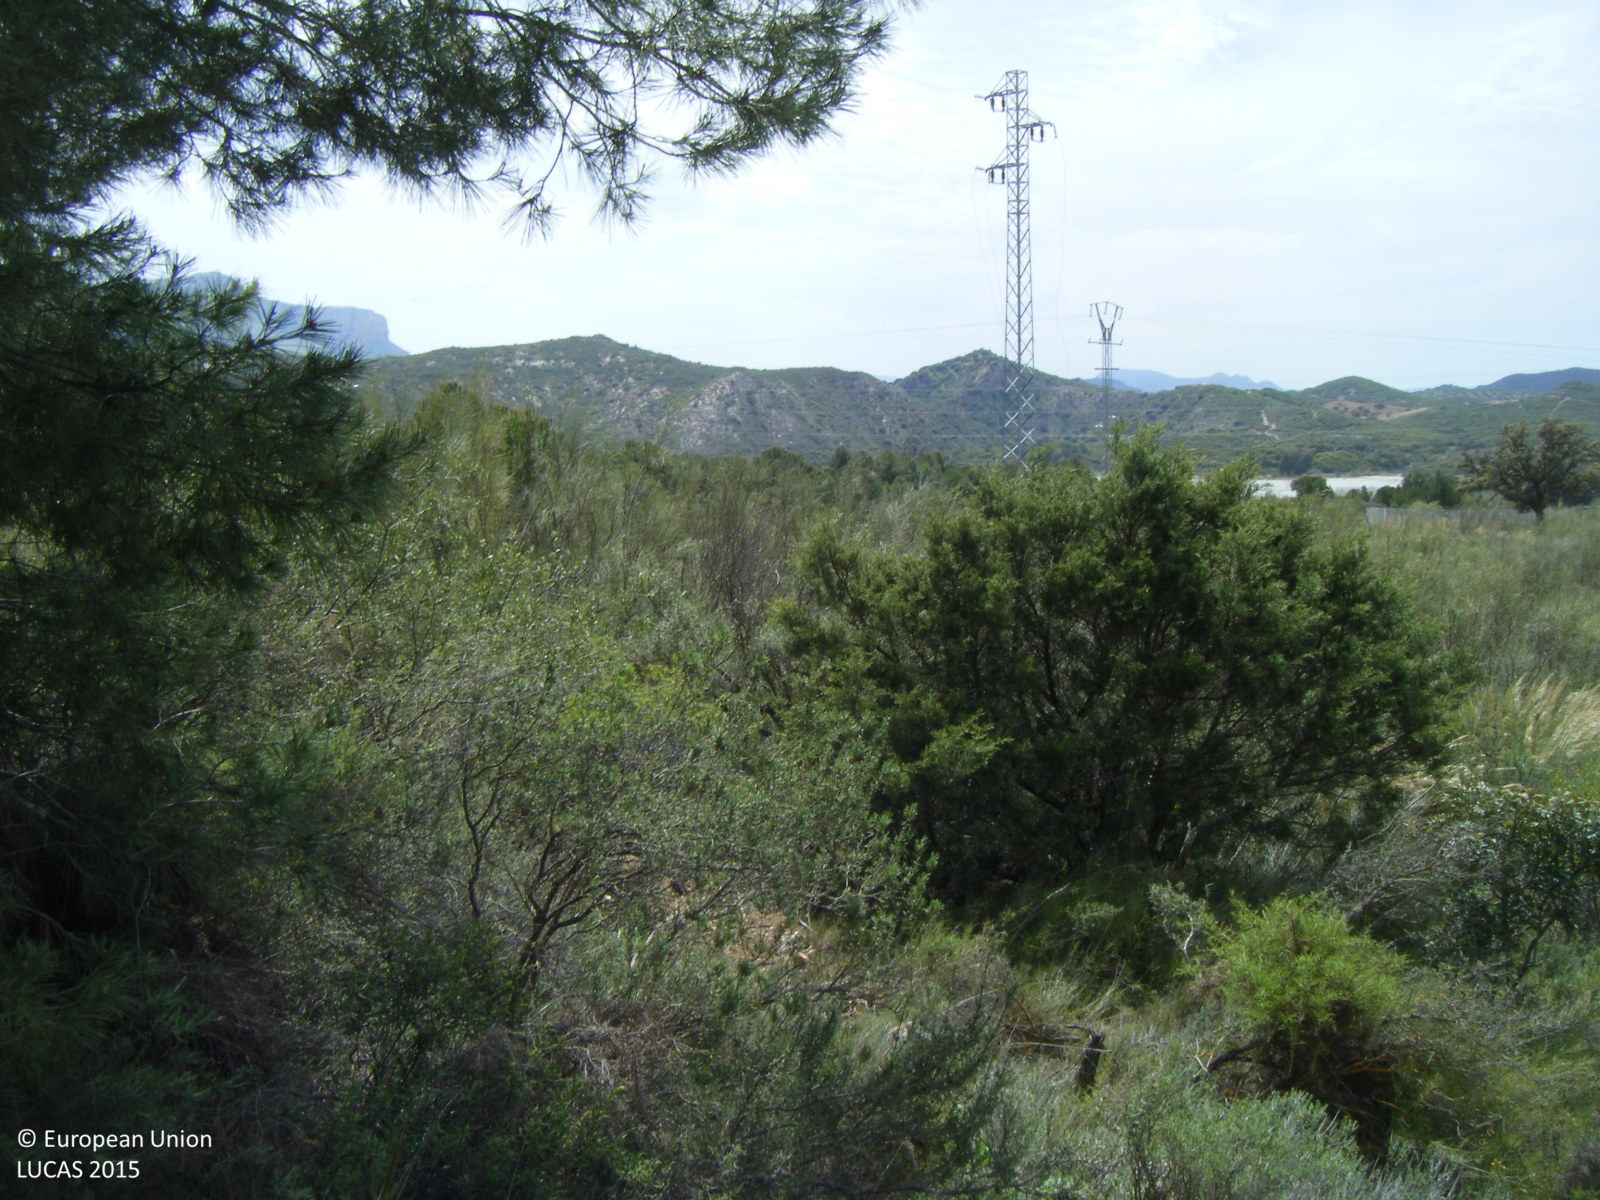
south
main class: Shrubland
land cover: Shrubland with sparse tree cover
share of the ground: > 75 %
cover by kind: shrubs 95 %, coniferous forest trees 5 %
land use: Semi-natural and natural areas not in use
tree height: > 5 m
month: April
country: ES
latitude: 36.9985
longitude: -4.7298
